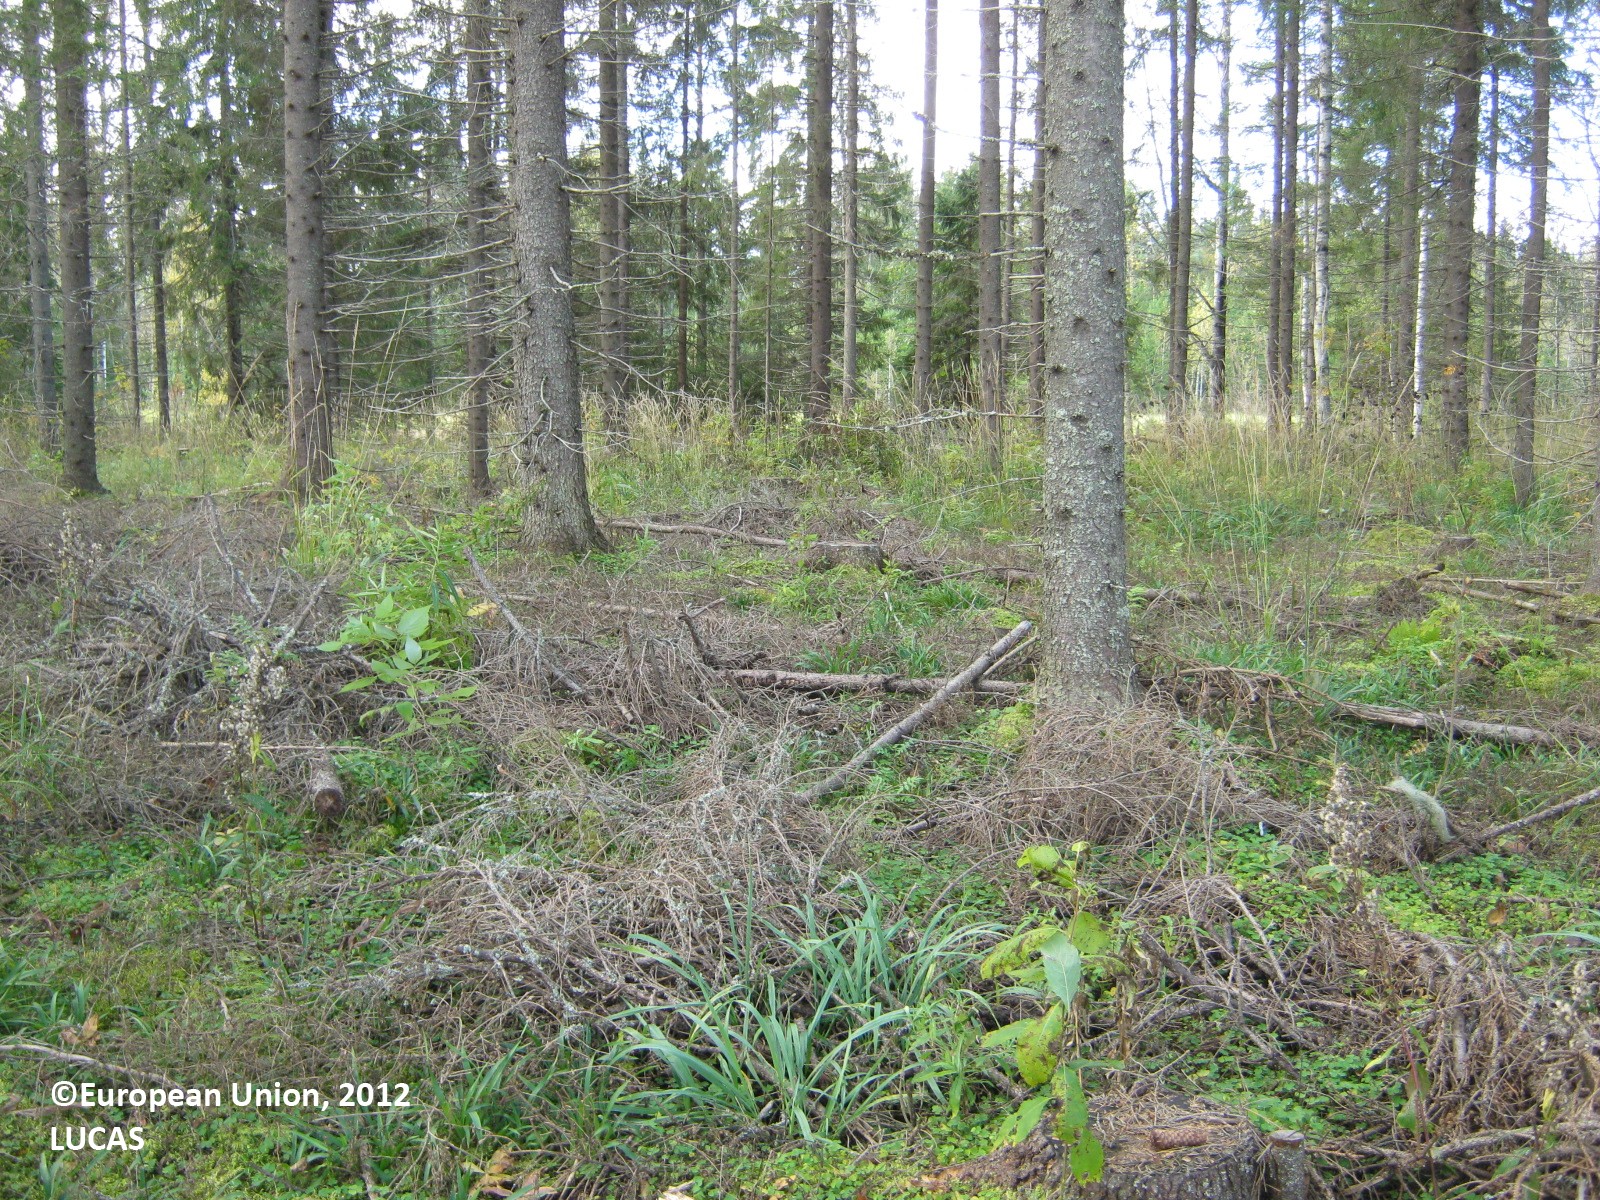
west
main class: Woodland
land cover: Spruce dominated coniferous woodland
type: boreal forest
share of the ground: 25 - 50 %
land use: Forestry
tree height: > 5 m
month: September
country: FI
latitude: 62.6094
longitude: 27.8493
